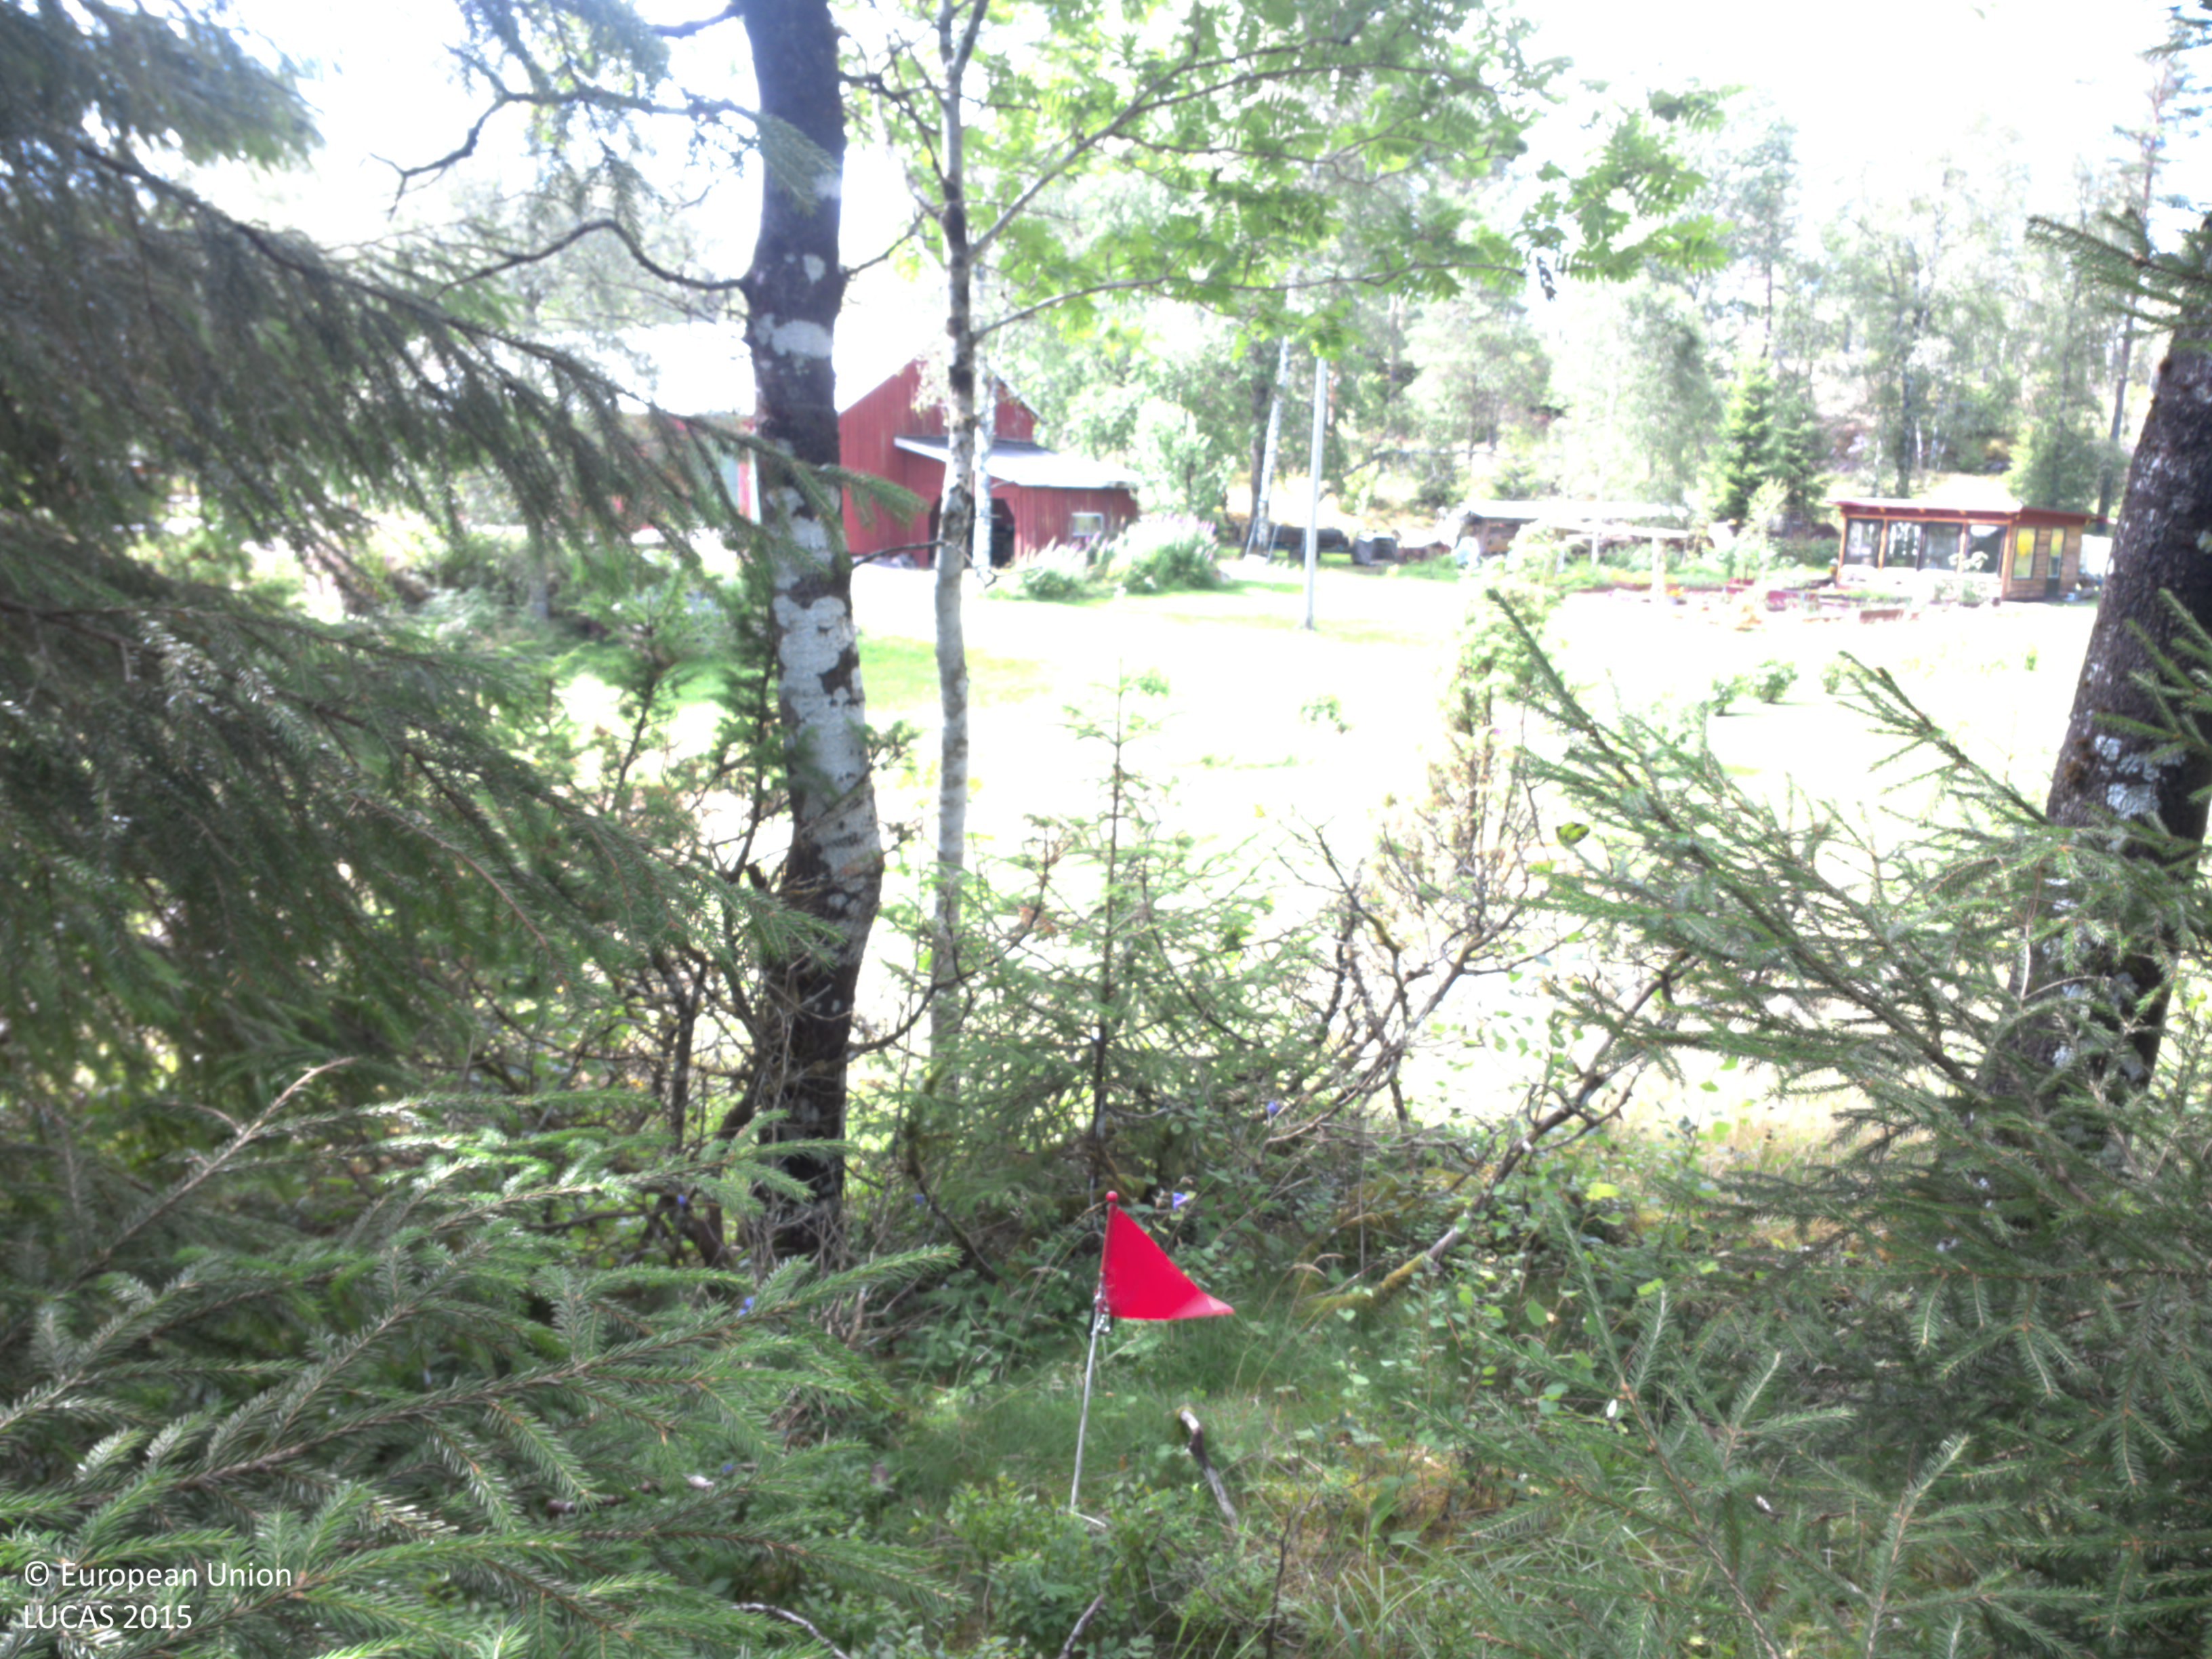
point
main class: Woodland
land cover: Spruce dominated mixed woodland
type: boreal forest
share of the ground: > 75 %
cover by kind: coniferous forest trees 60 %, broadleaved forest trees 20 %, herbaceous plants 10 %, lichens and mosses 10 %
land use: Forestry
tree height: > 5 m
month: July
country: SE
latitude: 58.5663
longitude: 11.8699
